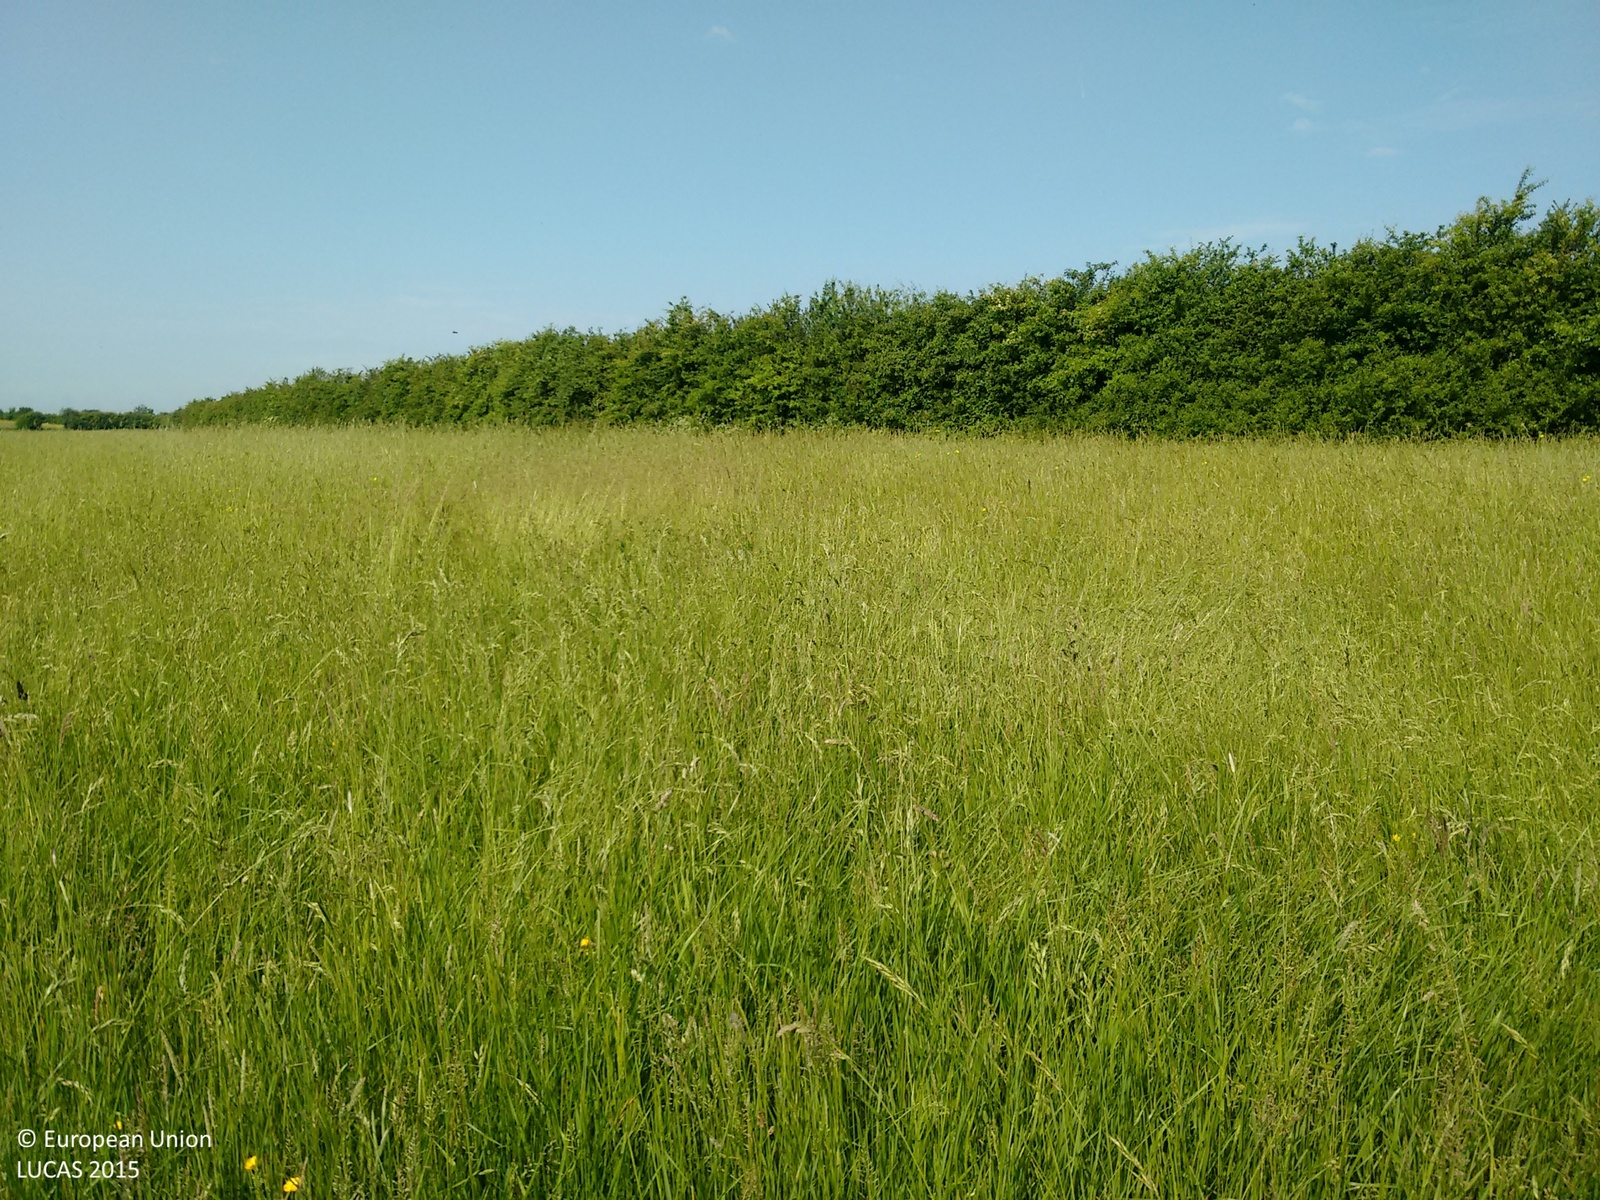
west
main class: Grassland
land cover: Grassland without tree/shrub cover
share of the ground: > 75 %
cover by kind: herbaceous plants 100 %
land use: Agriculture (excluding fallow land and kitchen gardens)
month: June
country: GB
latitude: 51.0336
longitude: 0.6906
